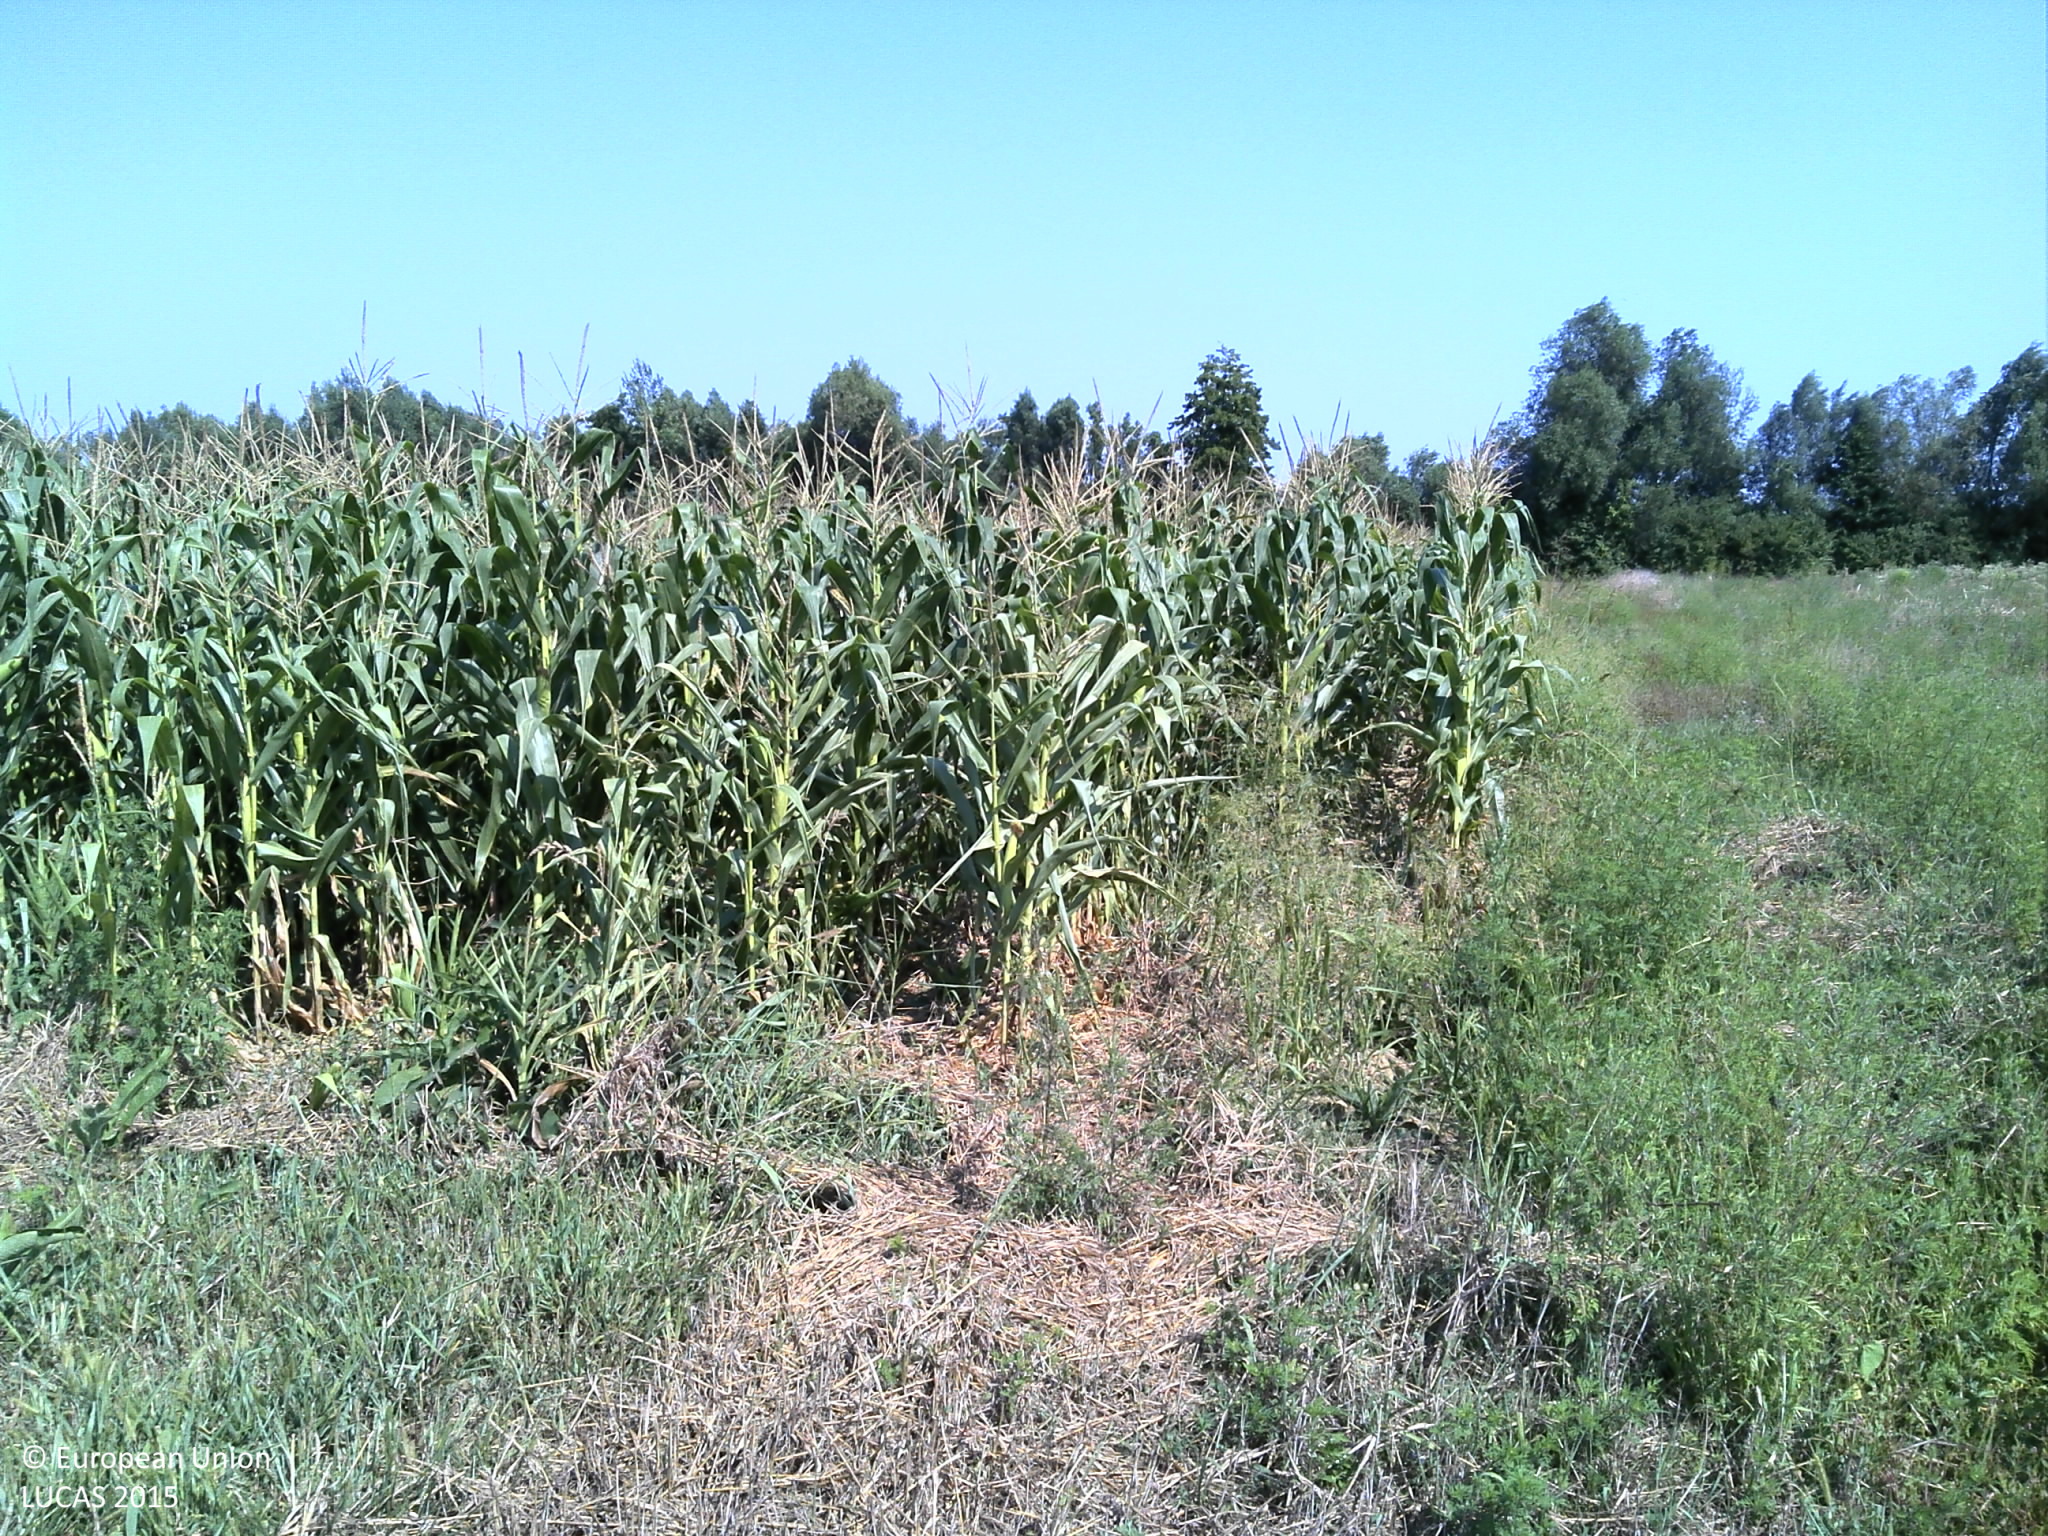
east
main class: Cropland
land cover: Barley
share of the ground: > 75 %
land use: Agriculture (excluding fallow land and kitchen gardens)
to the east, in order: Barley; Maize; Shrubland with sparse tree cover; Ditches and canals; Maize; Electric lines; Maize
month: August
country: HR
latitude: 45.5160
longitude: 16.2831
